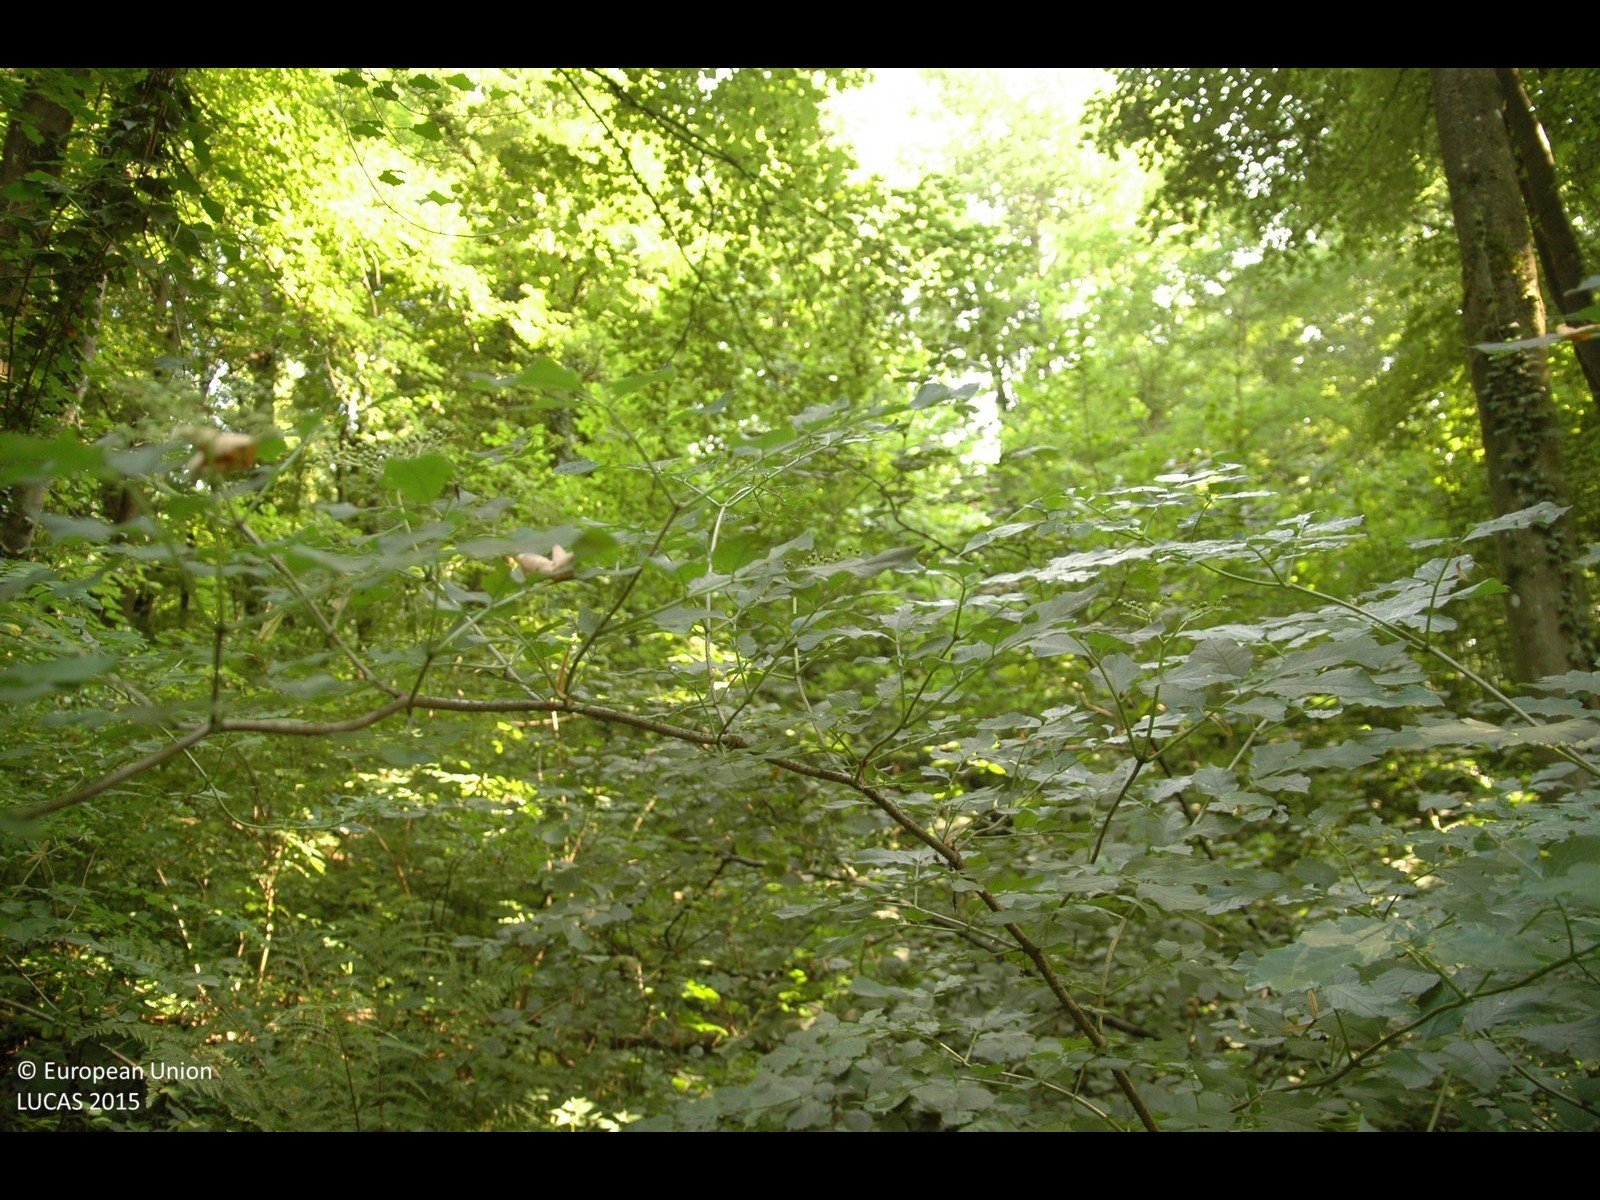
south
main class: Woodland
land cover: Broadleaved woodland
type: mesophytic deciduous forest
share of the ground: > 75 %
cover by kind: broadleaved forest trees 100 %
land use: Forestry
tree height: > 5 m
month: July
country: HR
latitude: 46.0305
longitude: 16.1356
